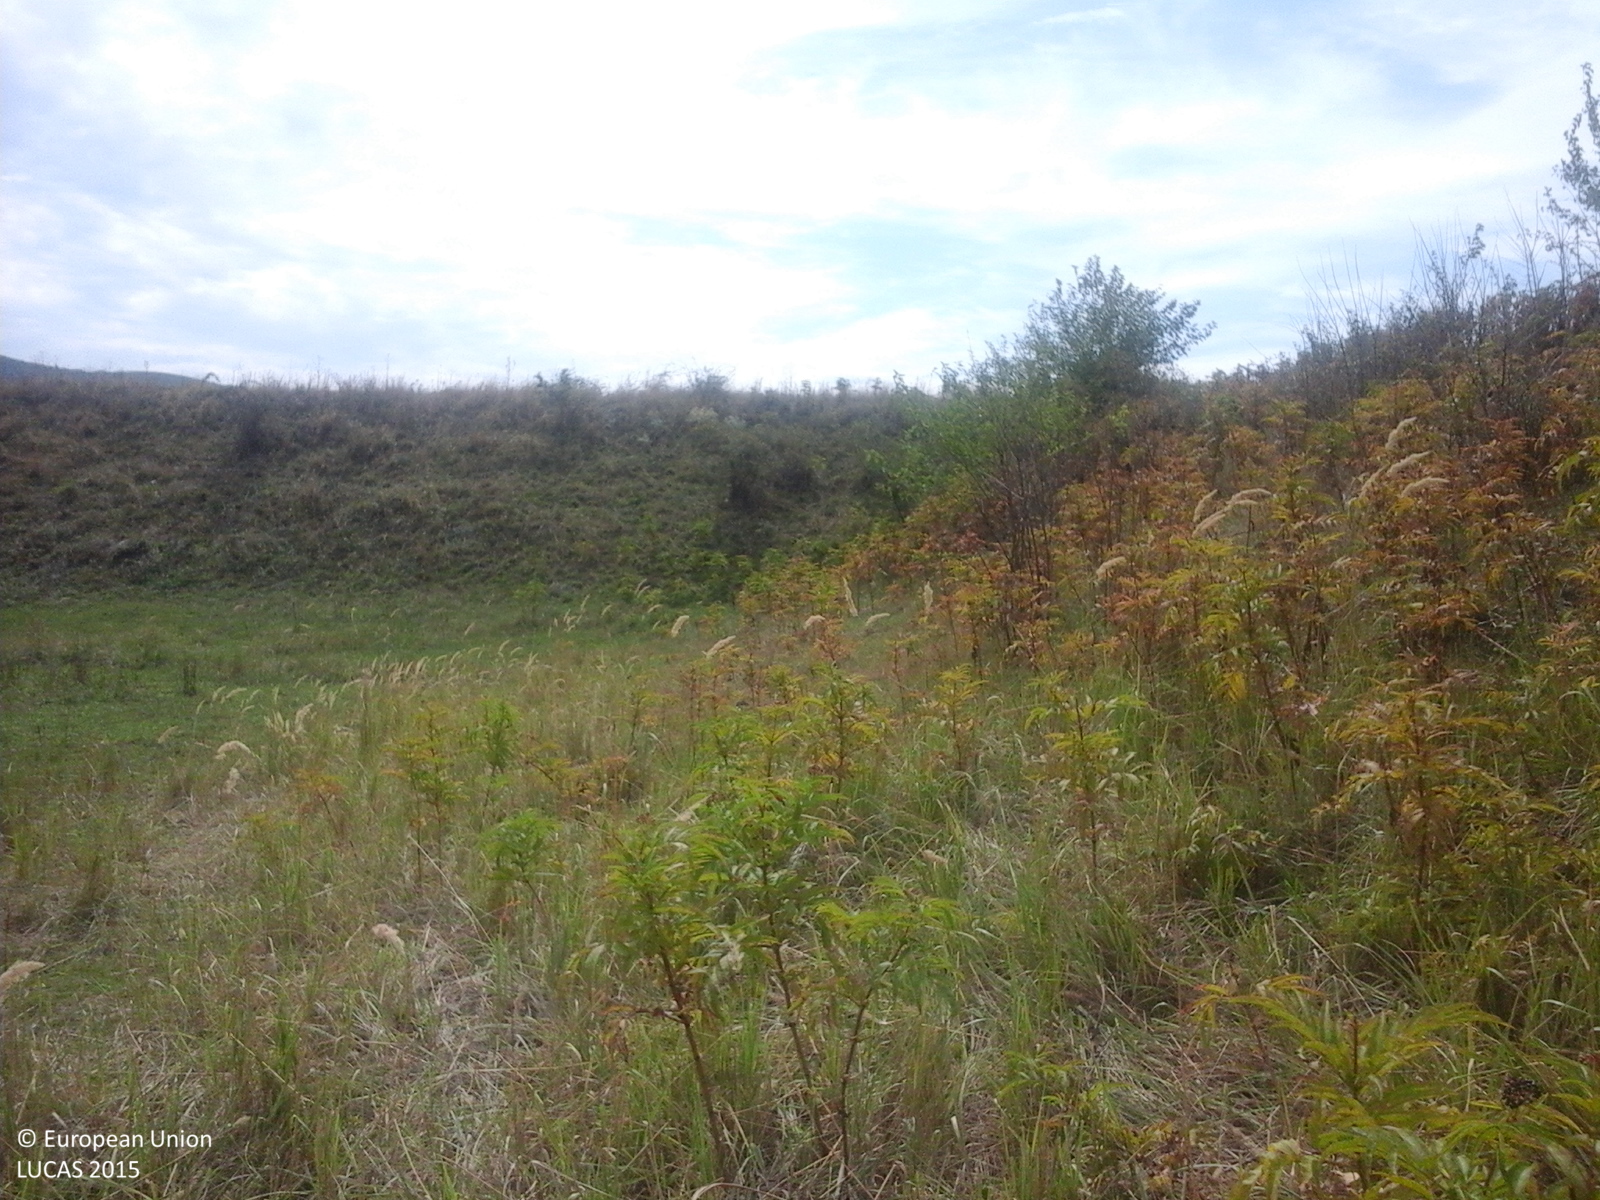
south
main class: Grassland
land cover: Spontaneously vegetated surfaces
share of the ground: > 75 %
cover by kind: herbaceous plants 100 %
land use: Fallow land
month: August
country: RO
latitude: 46.1365
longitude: 21.5963
